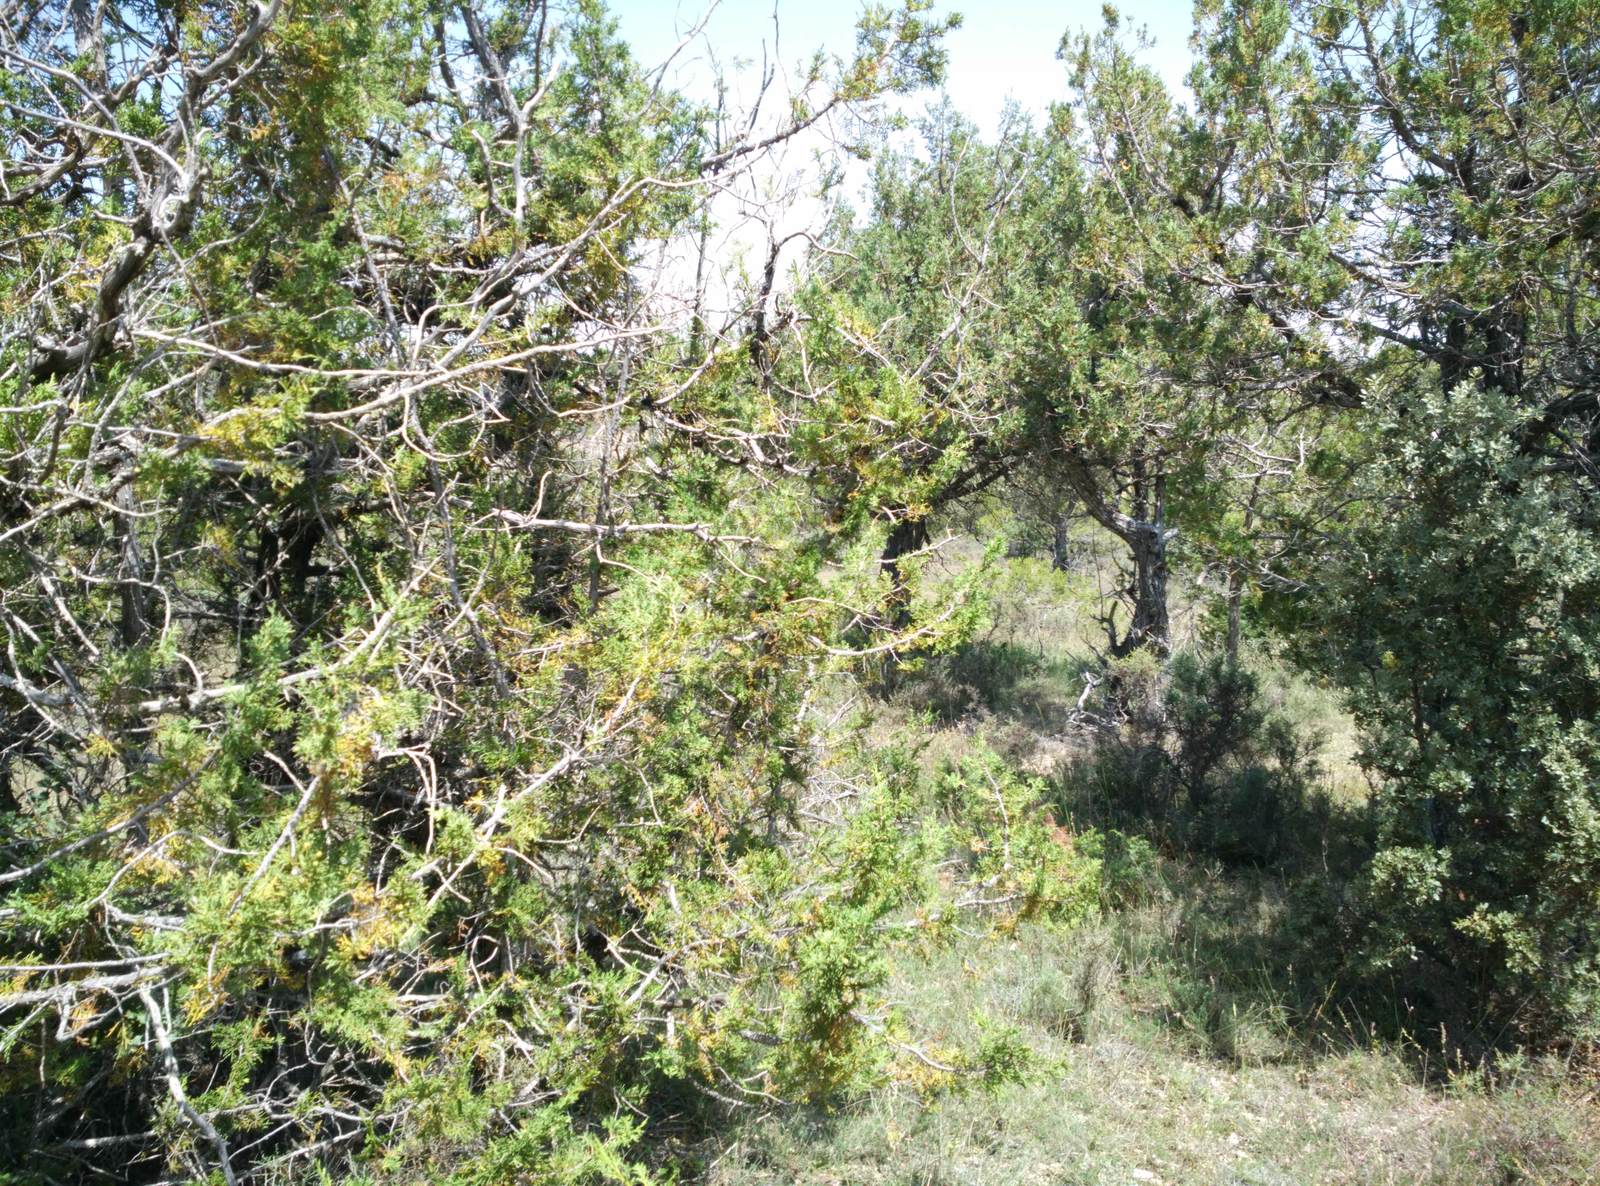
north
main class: Woodland
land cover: Other coniferous woodland
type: coniferous forest of the mediterranean region
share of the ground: 50 - 75 %
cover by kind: coniferous forest trees 50 %, unconsolidated bare surface 30 %, shrubs 20 %
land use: Semi-natural and natural areas not in use
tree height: > 5 m
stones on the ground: 25 - 50 %
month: July
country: ES
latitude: 41.0881
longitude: -2.0858
